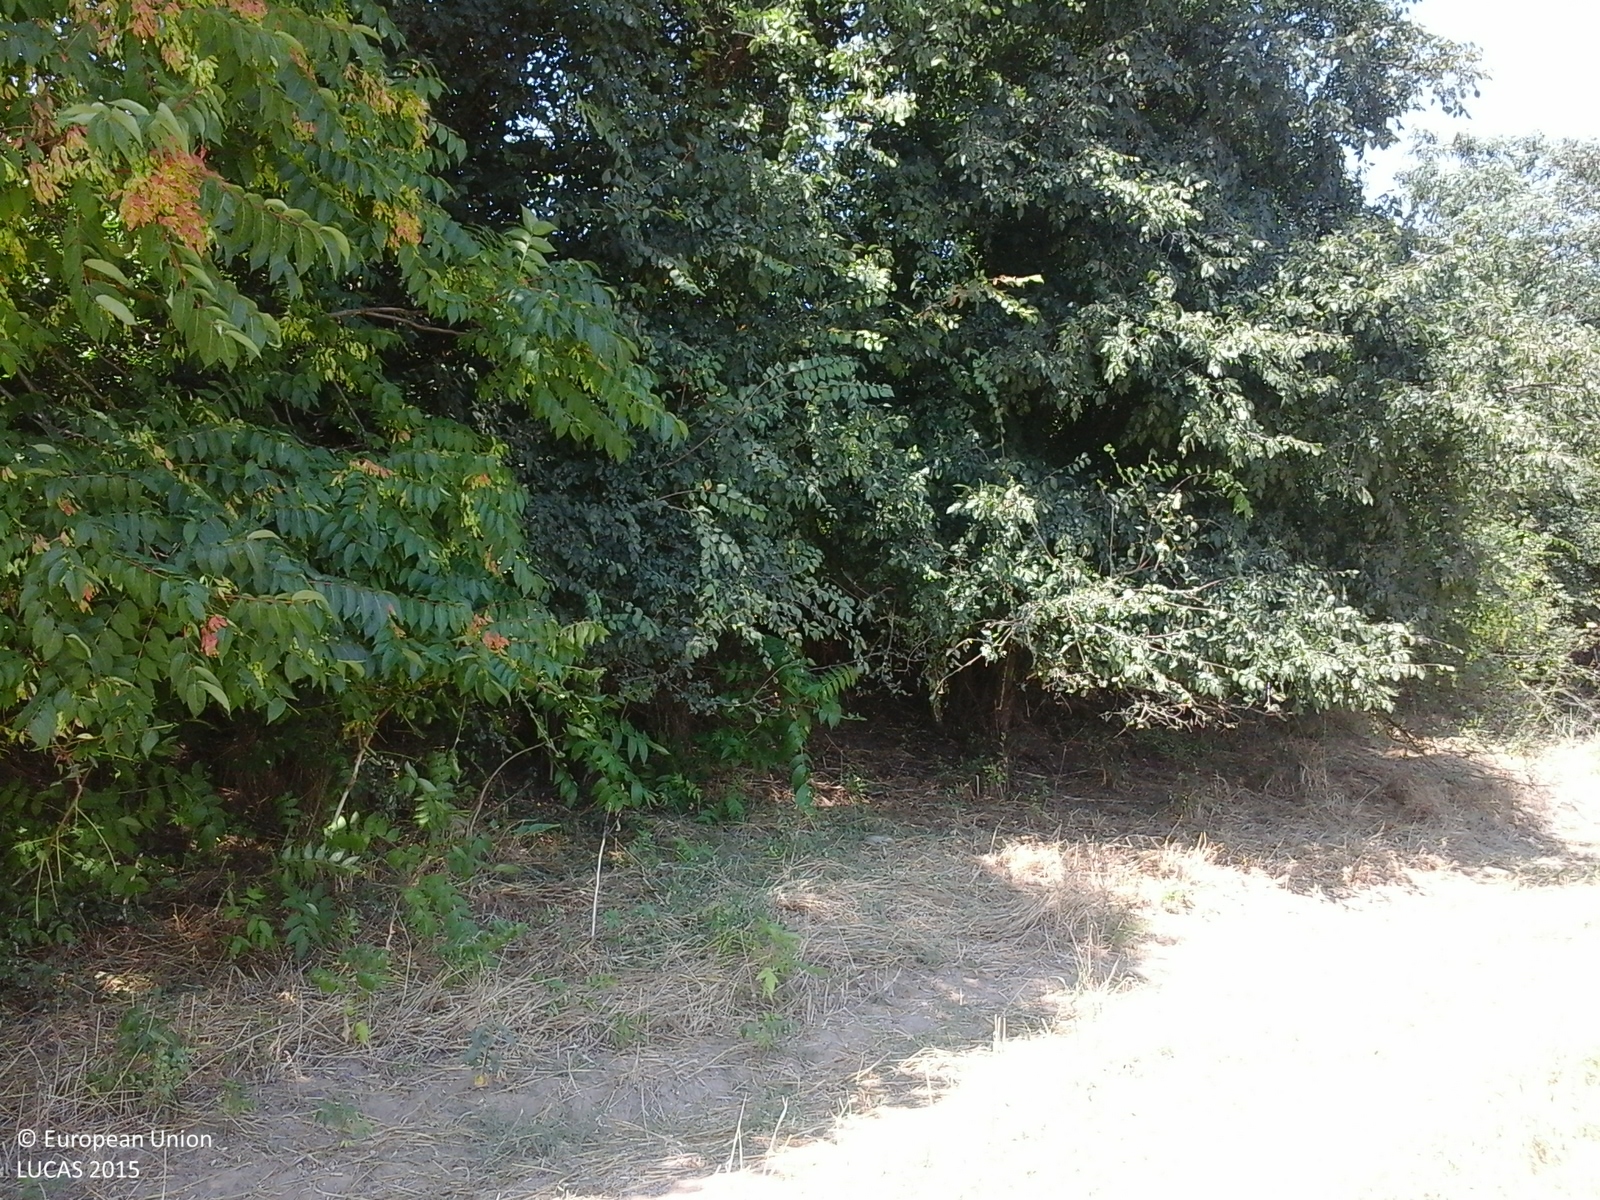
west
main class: Cropland
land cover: Common wheat
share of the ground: > 75 %
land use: Agriculture (excluding fallow land and kitchen gardens)
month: July
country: GR
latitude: 40.6527
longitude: 23.1971
